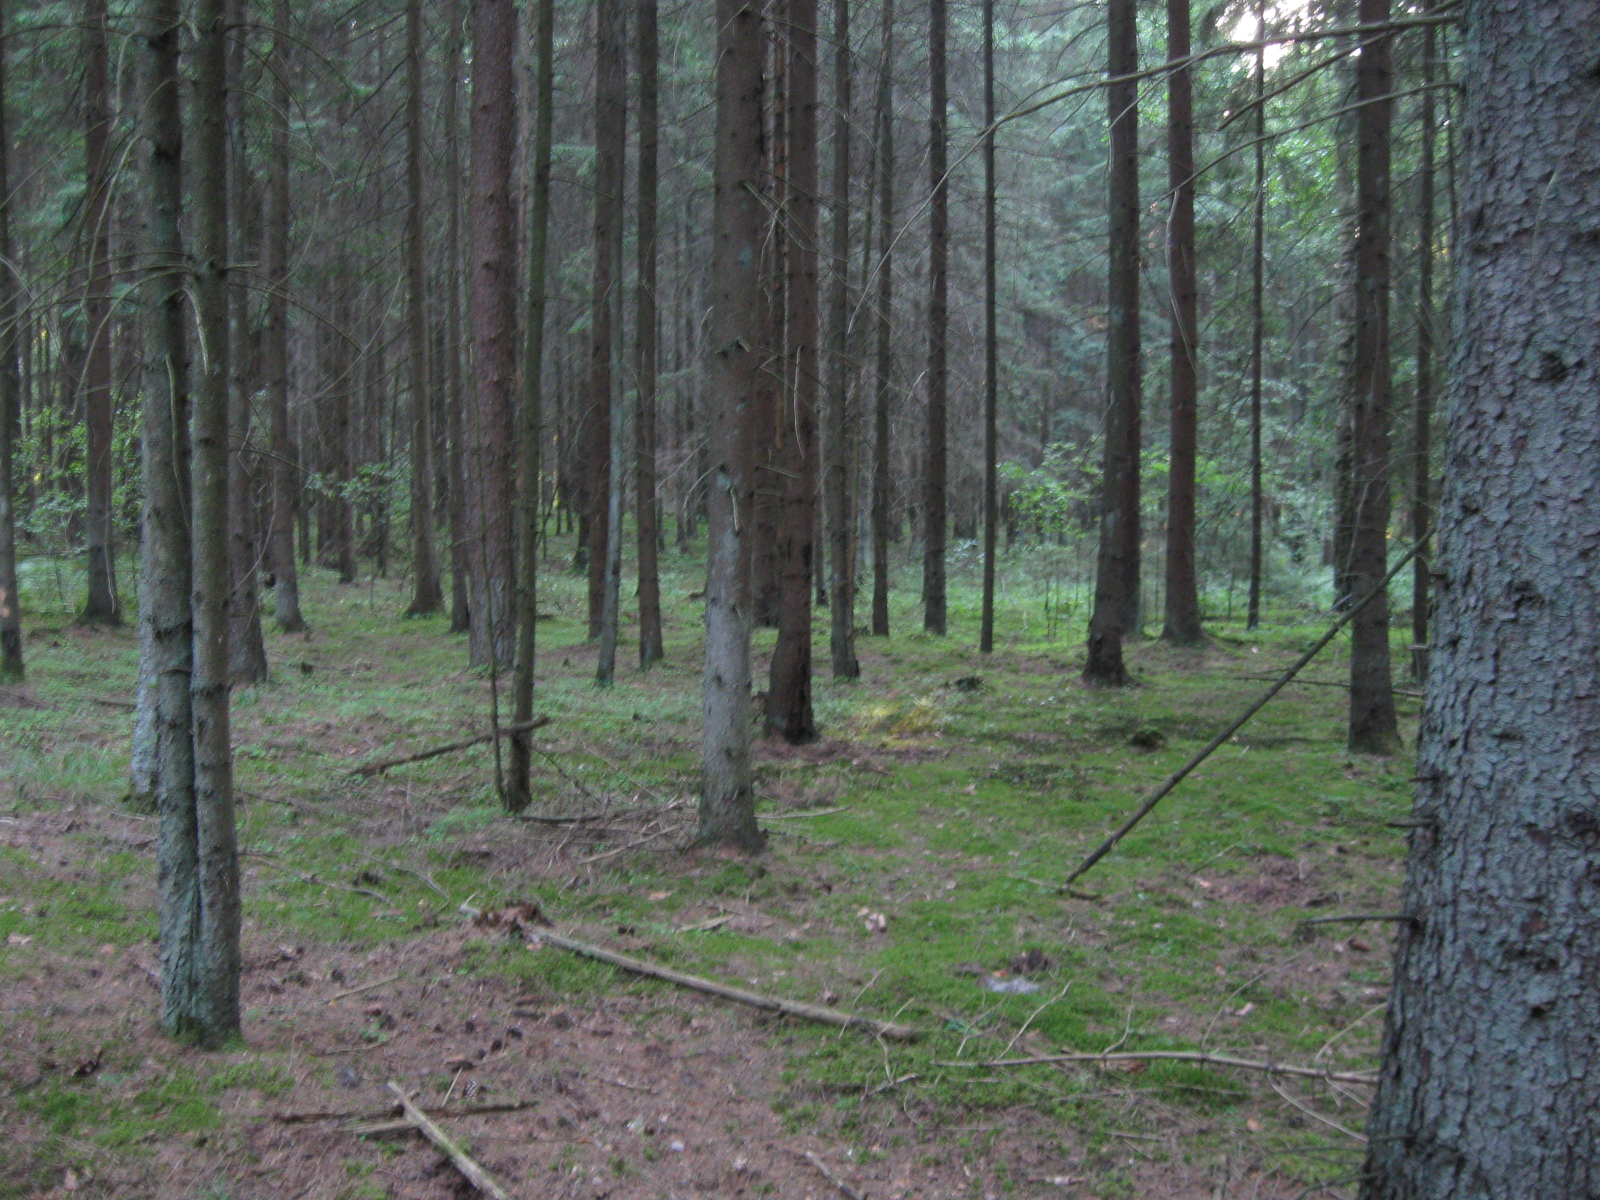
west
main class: Woodland
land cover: Spruce dominated coniferous woodland
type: hemiboreal forest and nemoral coniferous forest and mixed broadleaved-coniferous forest
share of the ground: > 75 %
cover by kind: coniferous forest trees 80 %, lichens and mosses 10 %, herbaceous plants 5 %, unconsolidated bare surface 5 %
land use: Forestry
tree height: > 5 m
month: August
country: LT
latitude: 54.7831
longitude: 23.4367
